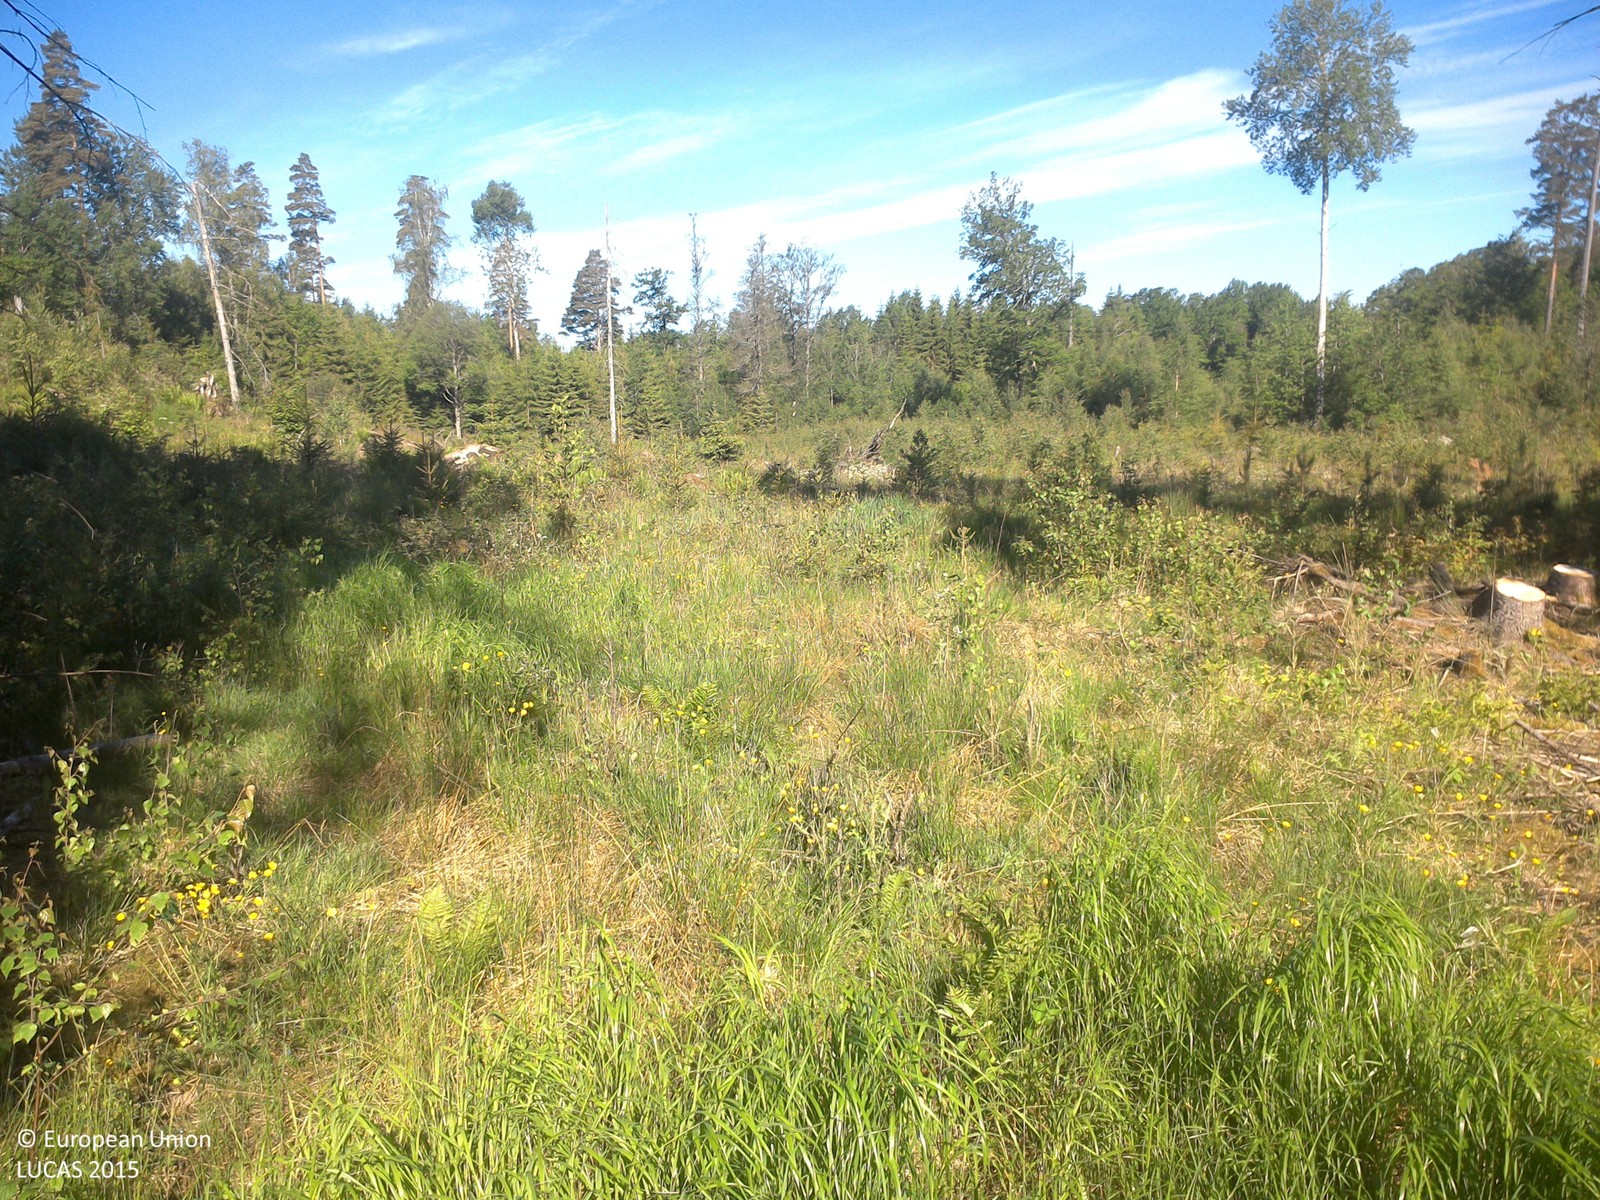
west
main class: Woodland
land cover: Spruce dominated coniferous woodland
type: boreal forest
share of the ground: 50 - 75 %
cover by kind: coniferous forest trees 65 %, lichens and mosses 30 %, broadleaved forest trees 5 %
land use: Forestry
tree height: > 5 m
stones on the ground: < 10 %
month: June
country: SE
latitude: 58.3160
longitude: 15.6792
